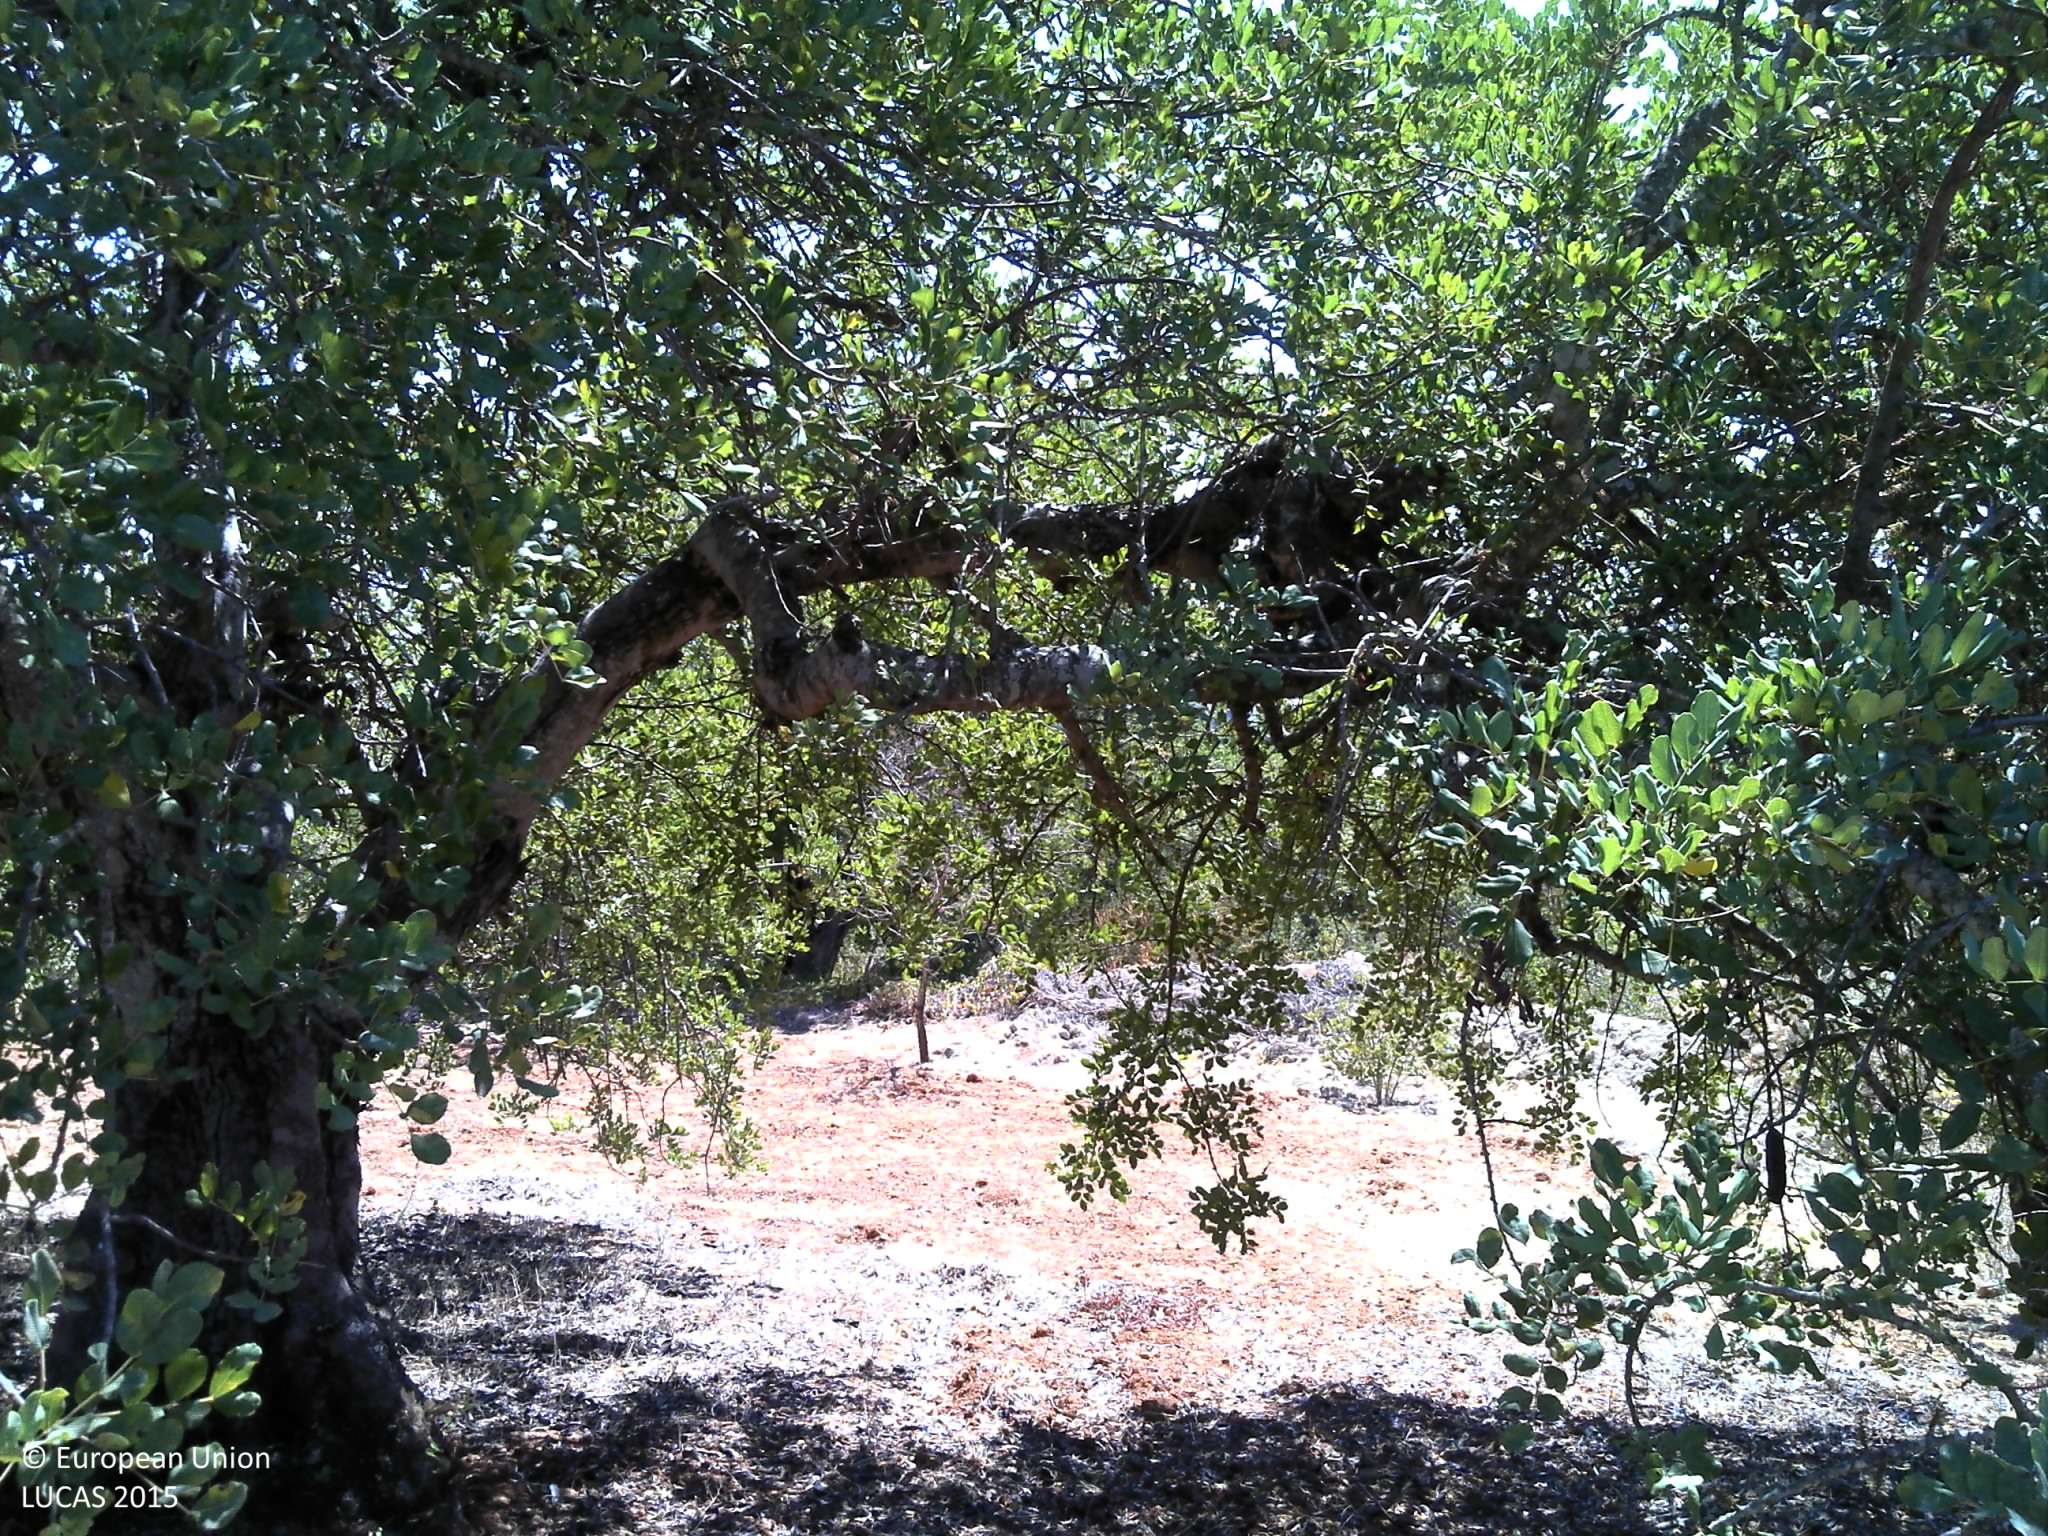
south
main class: Cropland
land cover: Permanent industrial crops
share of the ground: 25 - 50 %
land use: Agriculture (excluding fallow land and kitchen gardens)
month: September
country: PT
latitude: 37.1201
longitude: -8.1241
